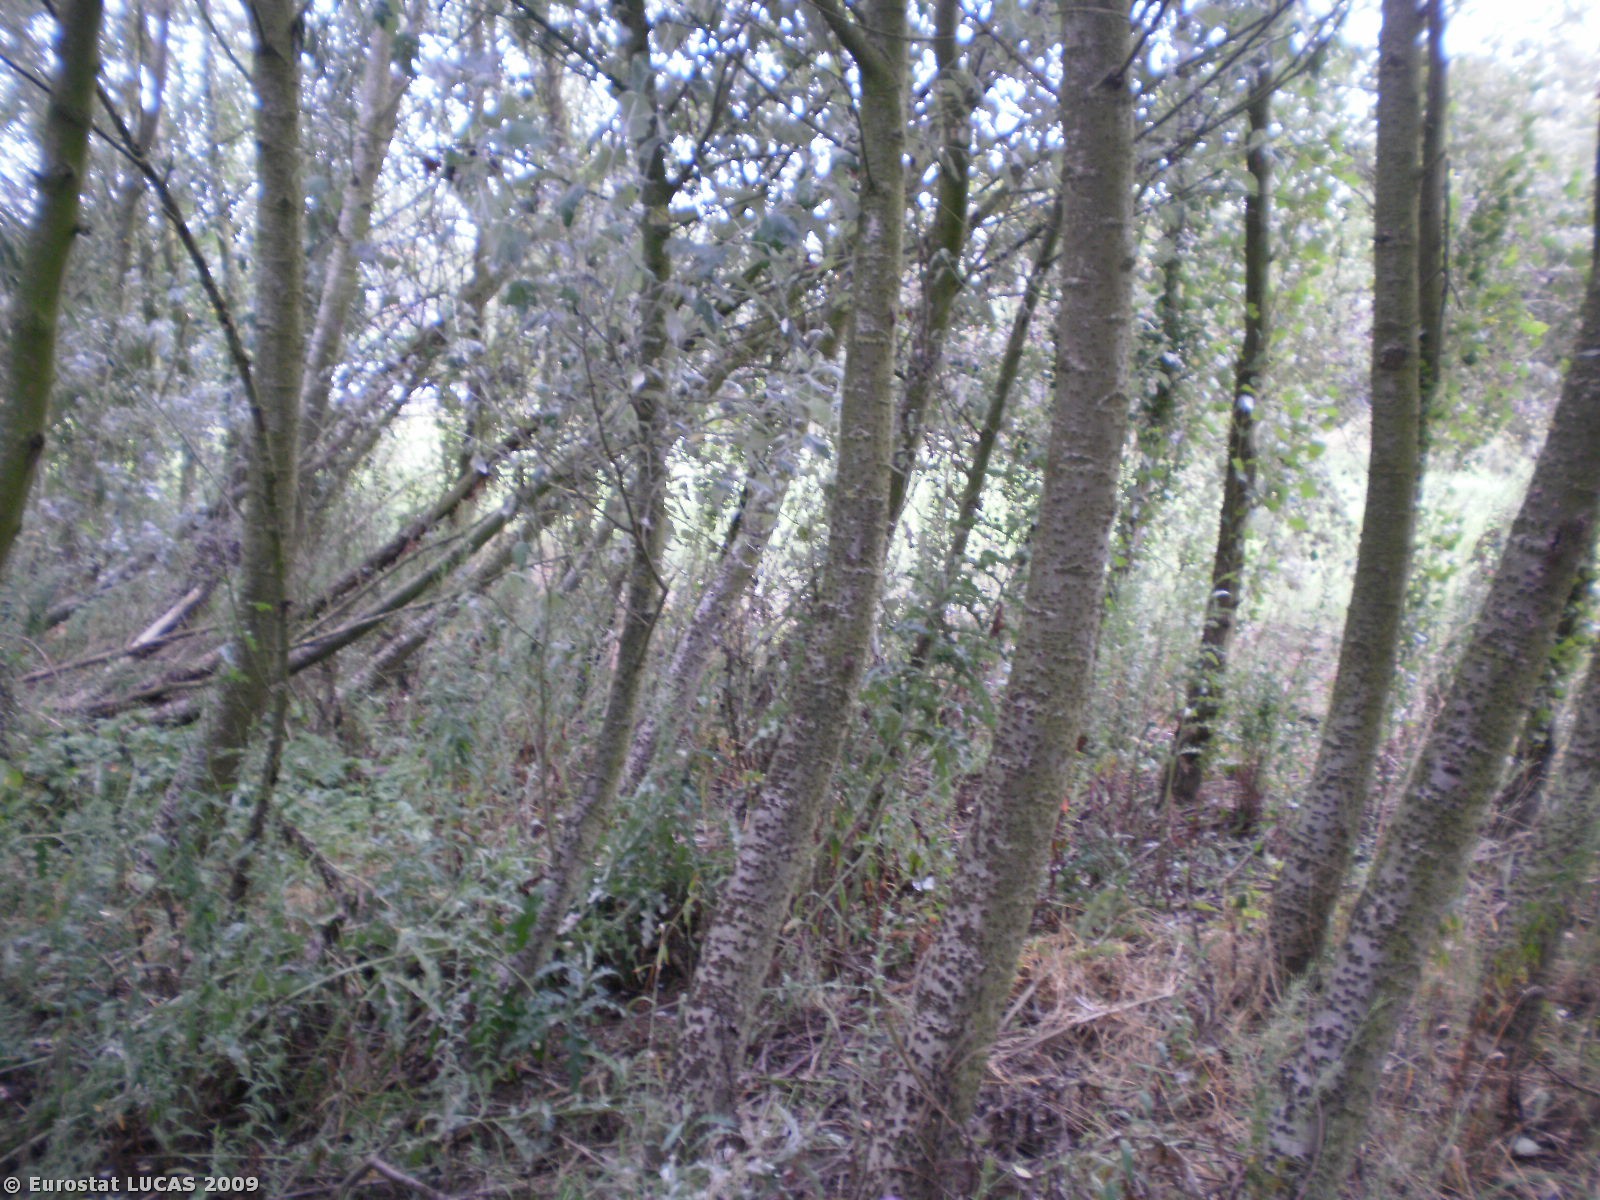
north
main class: Woodland
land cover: Broadleaved woodland
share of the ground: > 75 %
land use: Forestry
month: July
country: BE
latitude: 50.9231
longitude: 4.2619
